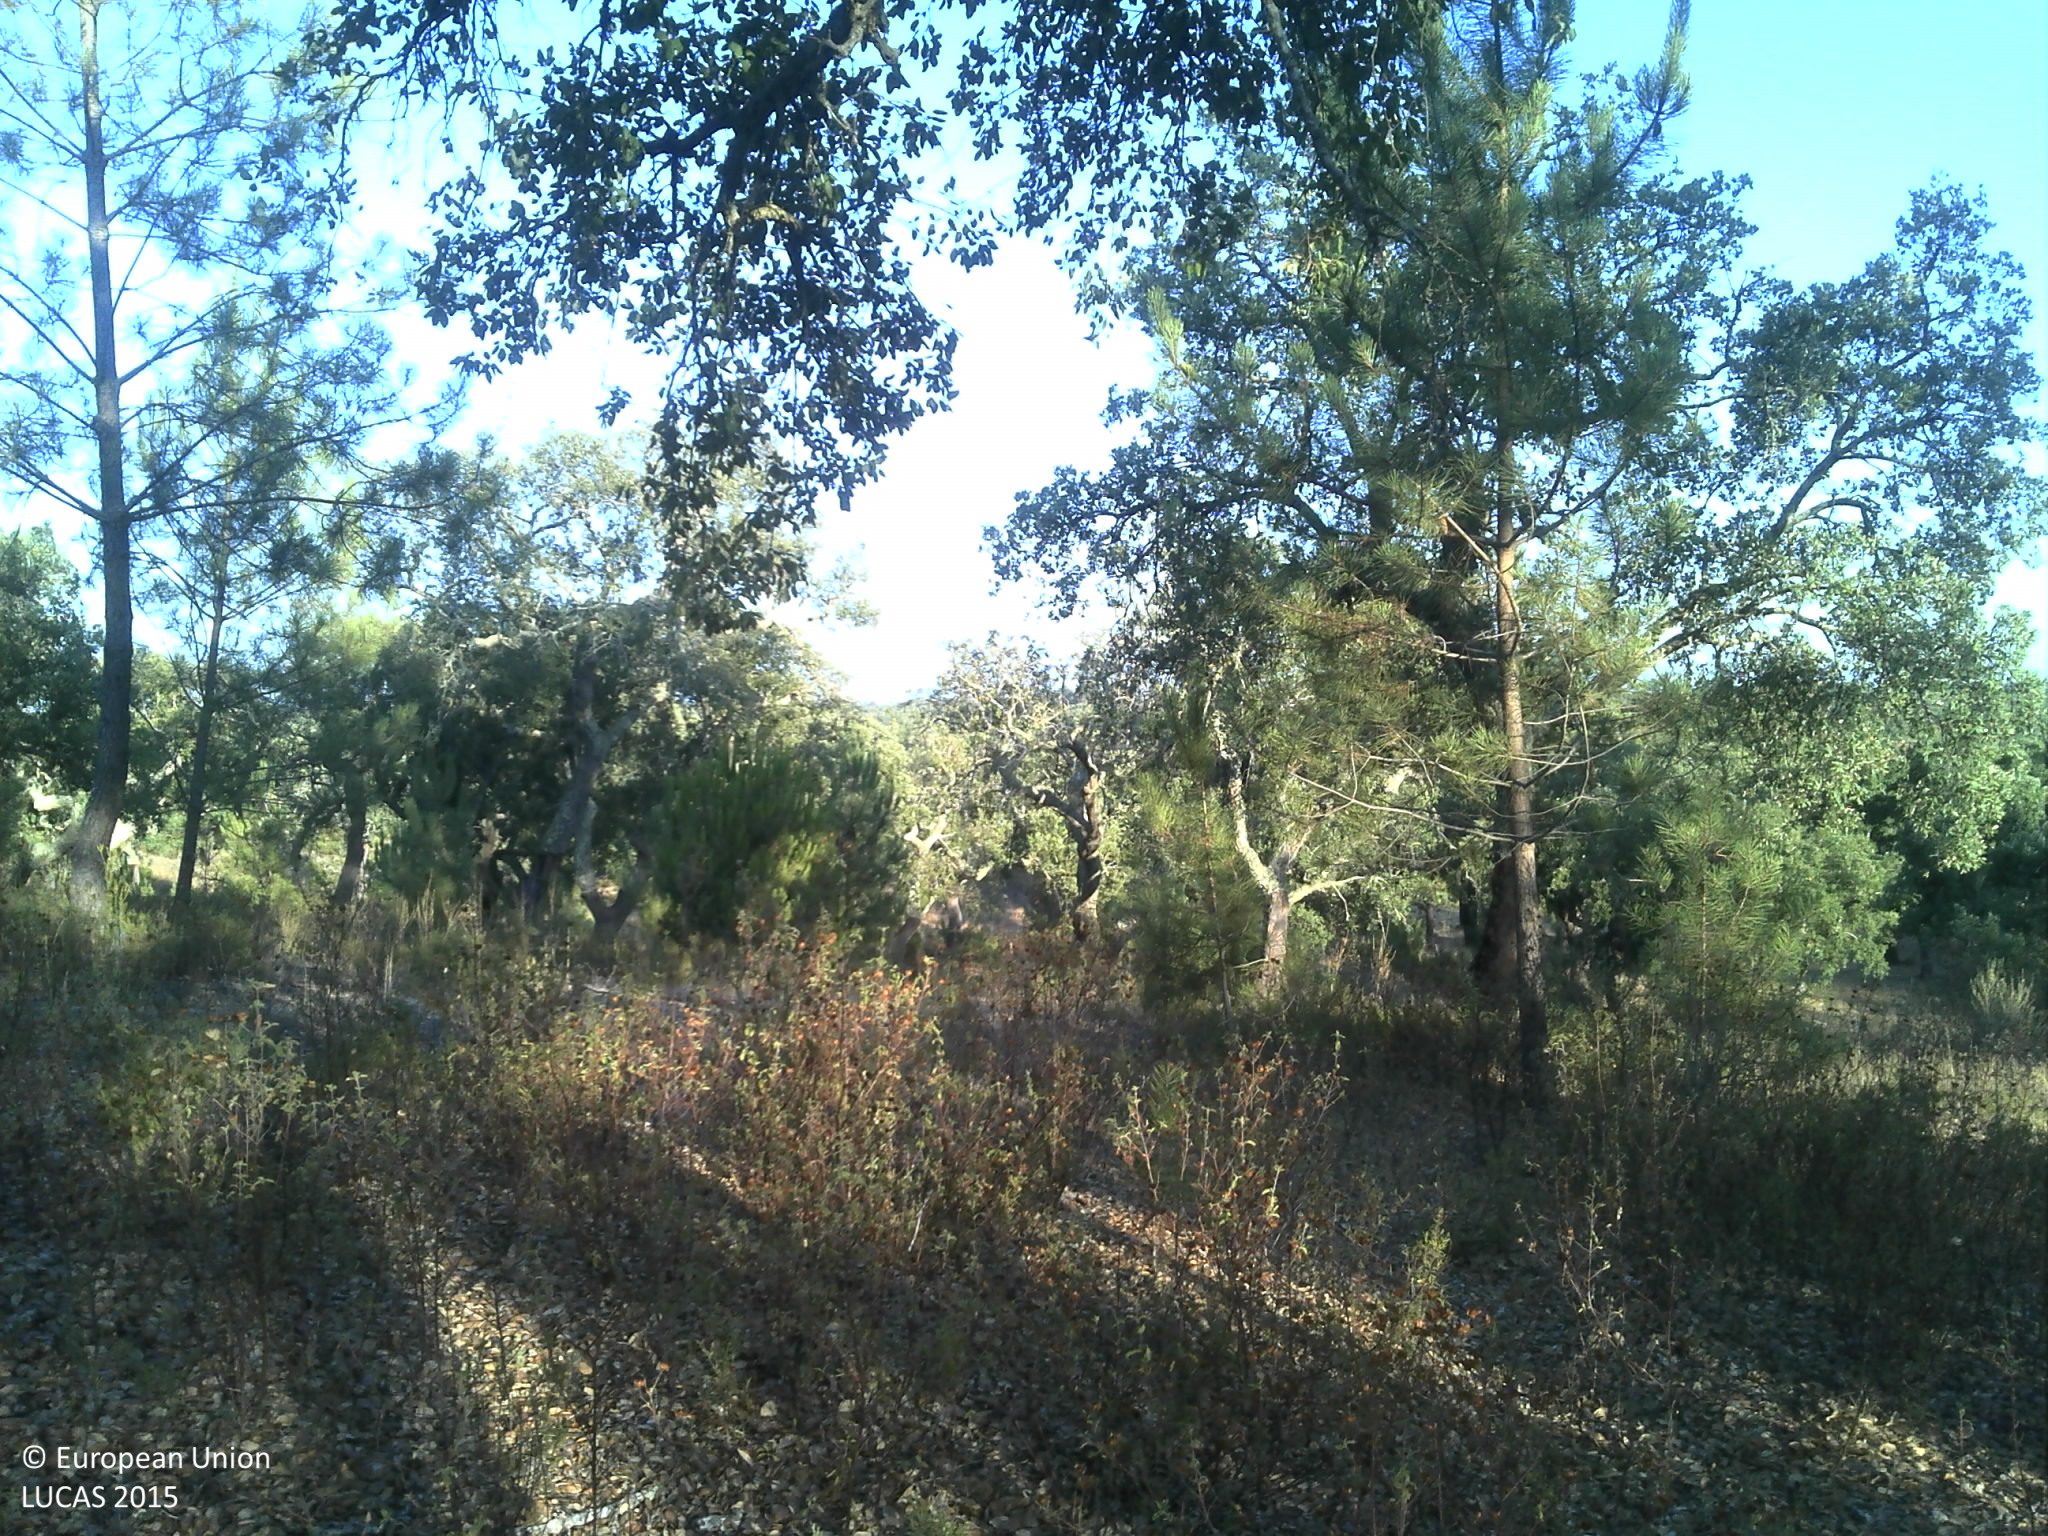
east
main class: Woodland
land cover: Broadleaved woodland
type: broadleaved evergreen forest
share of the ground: 25 - 50 %
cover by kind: broadleaved forest trees 50 %, unconsolidated bare surface 25 %, herbaceous plants 15 %, shrubs 10 %
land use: Forestry
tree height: > 5 m
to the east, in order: Broadleaved woodland
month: July
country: PT
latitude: 38.9370
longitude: -8.2007
